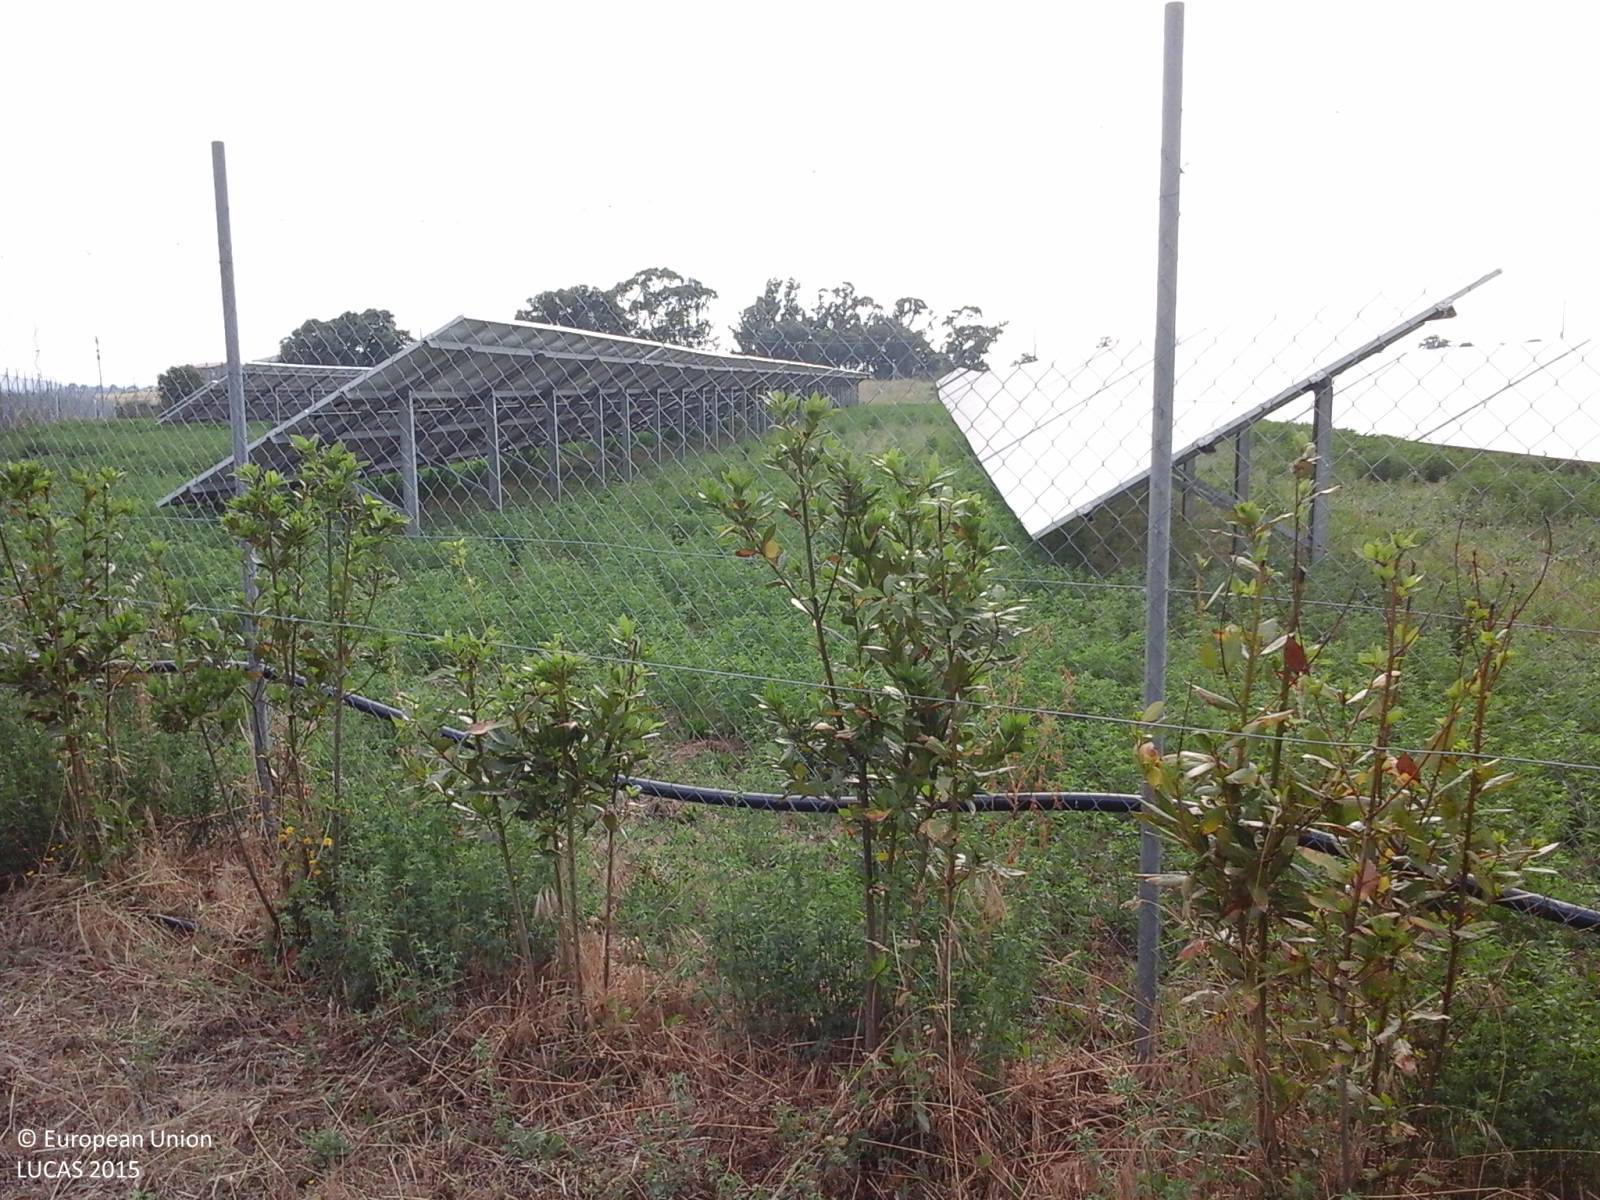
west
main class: Cropland
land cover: Lucerne
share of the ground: > 75 %
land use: Agriculture (excluding fallow land and kitchen gardens)
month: June
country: IT
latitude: 42.4064
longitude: 11.6104
